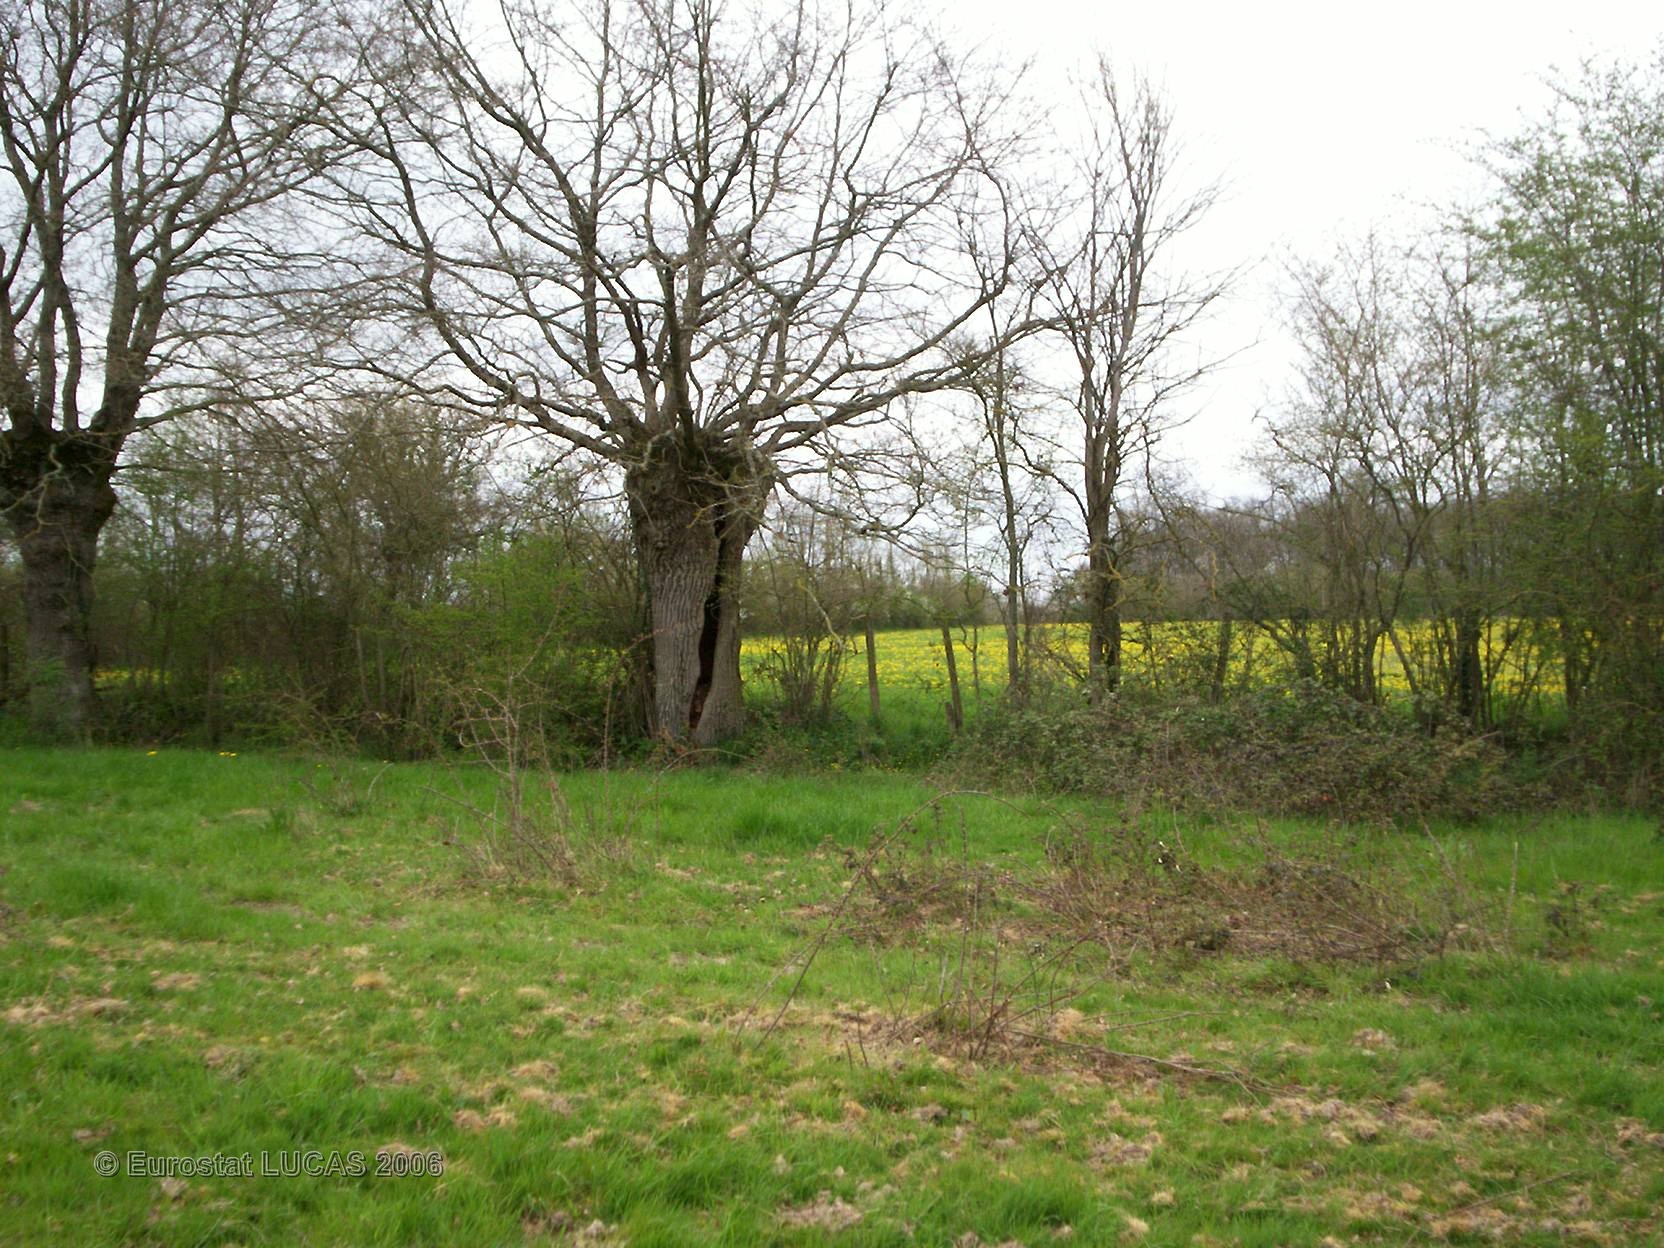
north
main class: Grassland
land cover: Grassland without tree/shrub cover
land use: Agriculture (excluding fallow land and kitchen gardens)
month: April
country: FR
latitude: 47.5617
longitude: 0.1265
